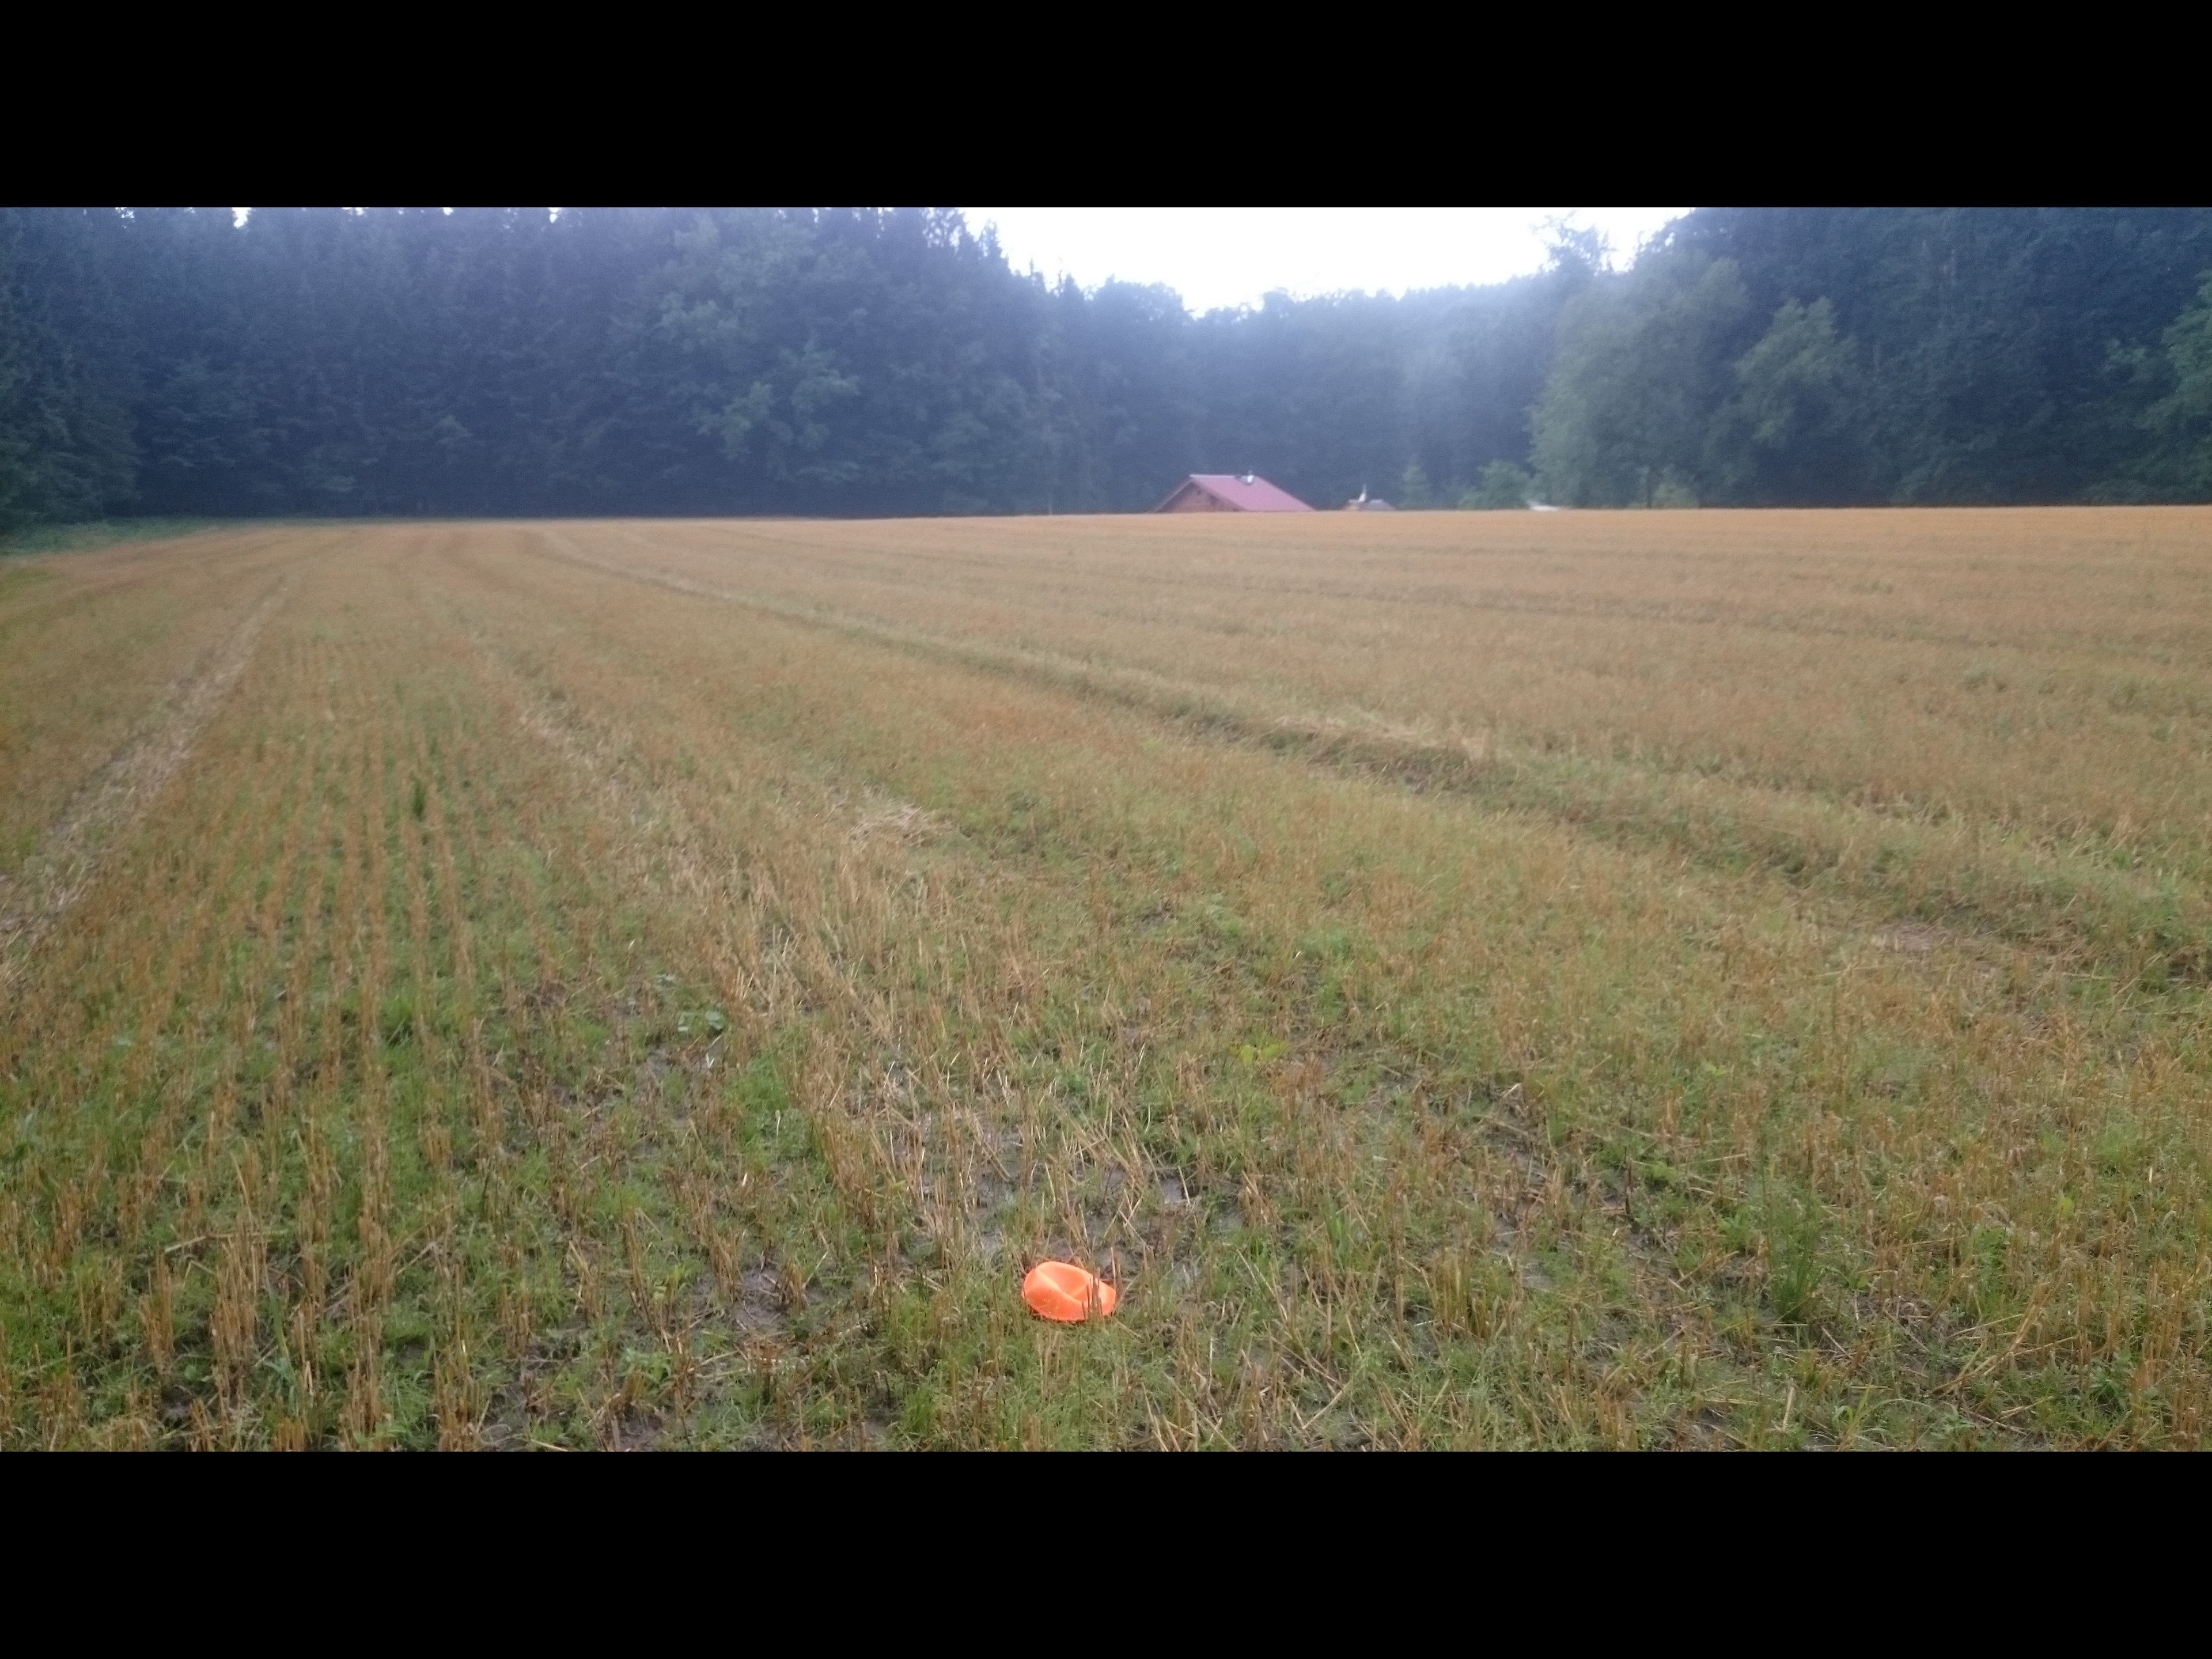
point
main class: Grassland
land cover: Spontaneously vegetated surfaces
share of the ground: > 75 %
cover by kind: herbaceous plants 100 %
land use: Agriculture (excluding fallow land and kitchen gardens)
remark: Harvested field
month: July
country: AT
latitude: 47.1926
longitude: 15.6892
